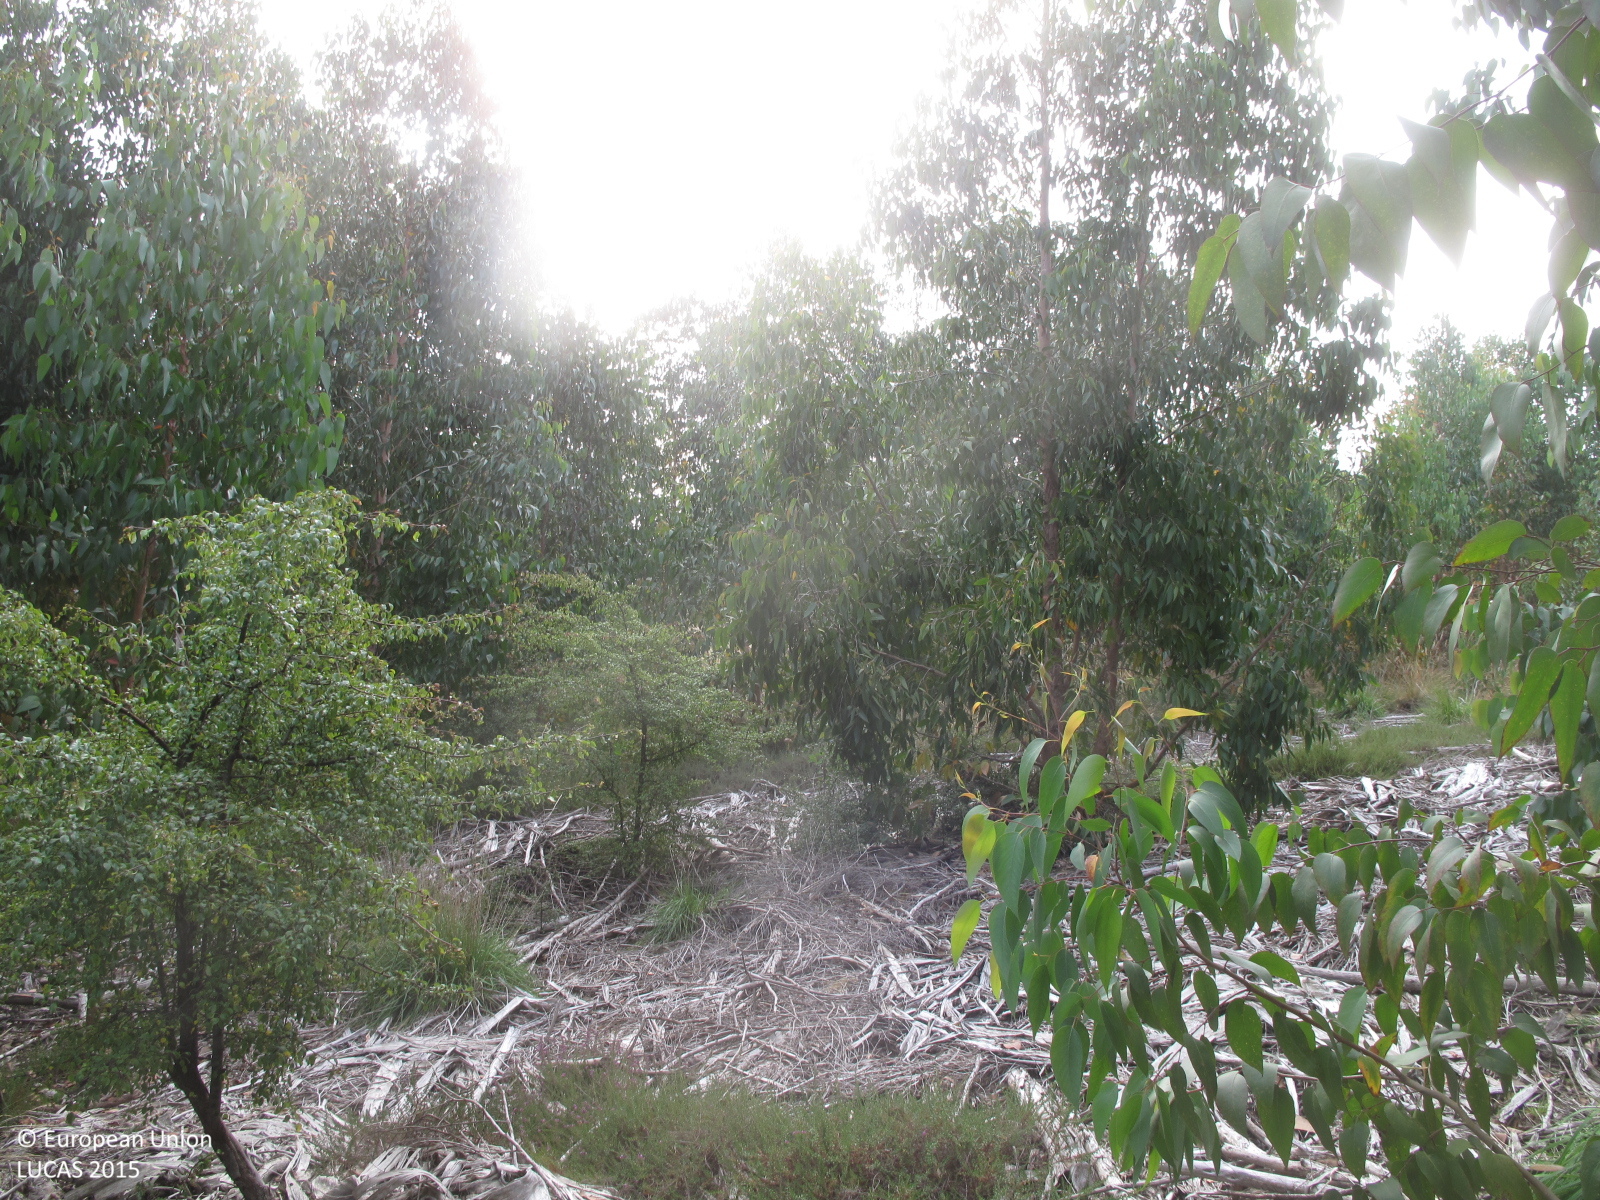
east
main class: Woodland
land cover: Broadleaved woodland
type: exotic forest
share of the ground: 50 - 75 %
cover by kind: broadleaved forest trees 60 %, unconsolidated bare surface 20 %, shrubs 10 %, herbaceous plants 10 %
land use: Forestry
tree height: > 5 m
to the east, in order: Broadleaved woodland; Grassland with sparse tree/shrub cover; Broadleaved woodland; Shrubland with sparse tree cover; Broadleaved woodland
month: July
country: ES
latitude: 43.2951
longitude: -8.1048
